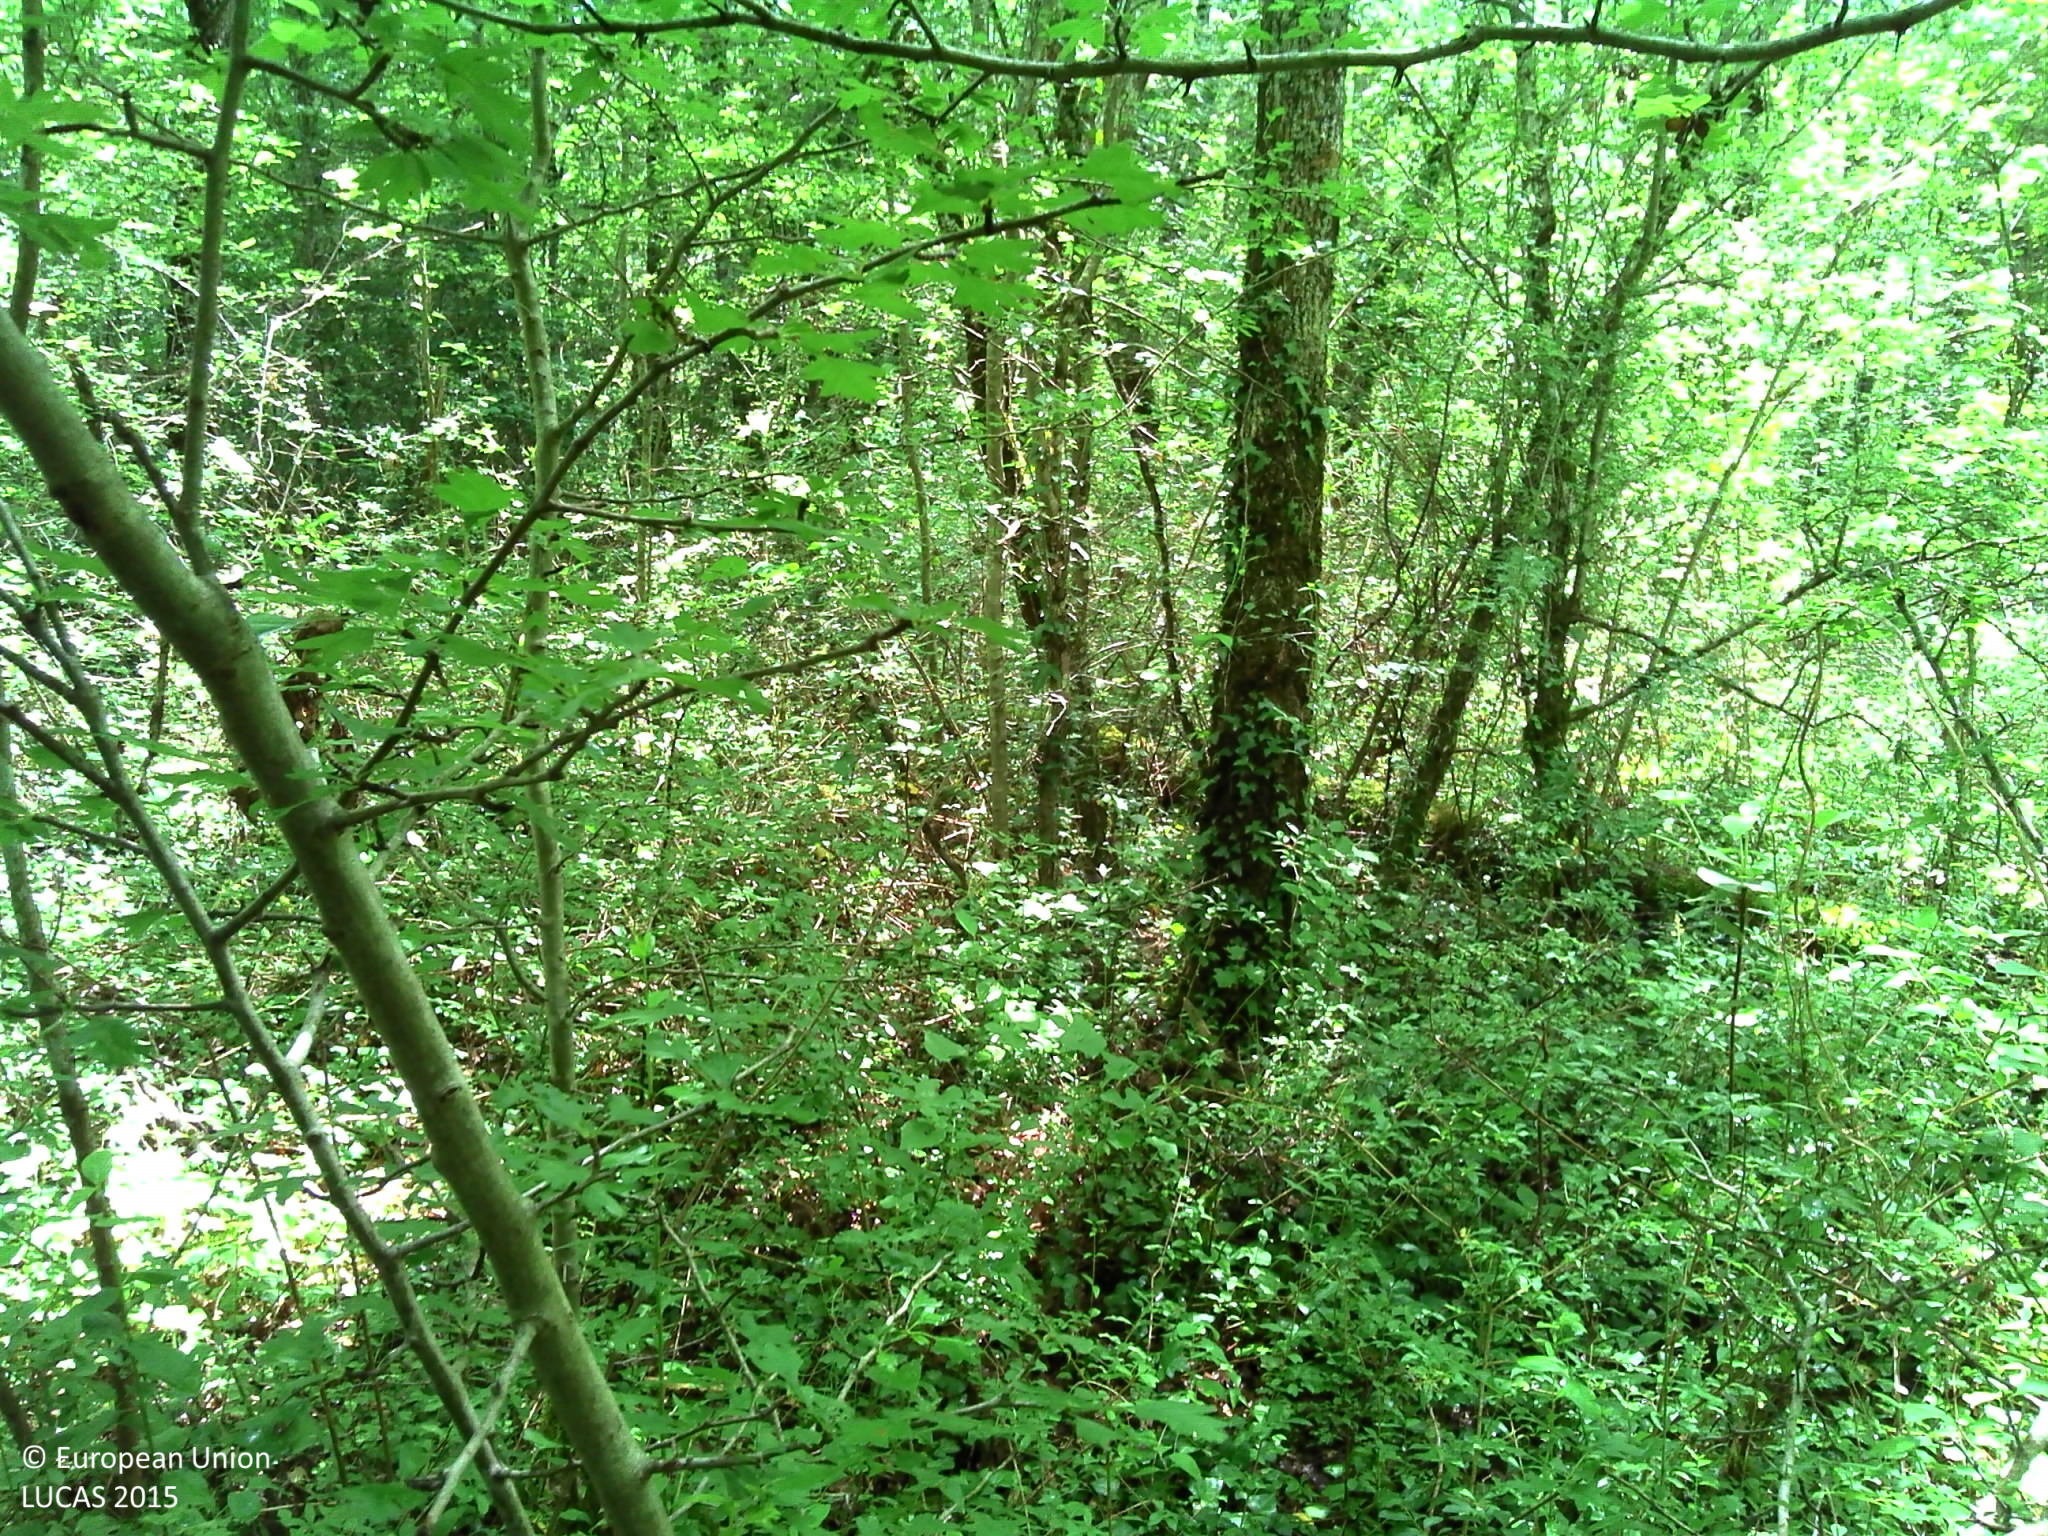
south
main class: Woodland
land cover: Broadleaved woodland
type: acidophilous oak and oak-birch forest
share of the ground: > 75 %
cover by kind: broadleaved forest trees 75 %, herbaceous plants 15 %, shrubs 5 %, lichens and mosses 5 %
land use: Forestry
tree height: > 5 m
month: June
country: FR
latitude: 44.2867
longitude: 1.8933
